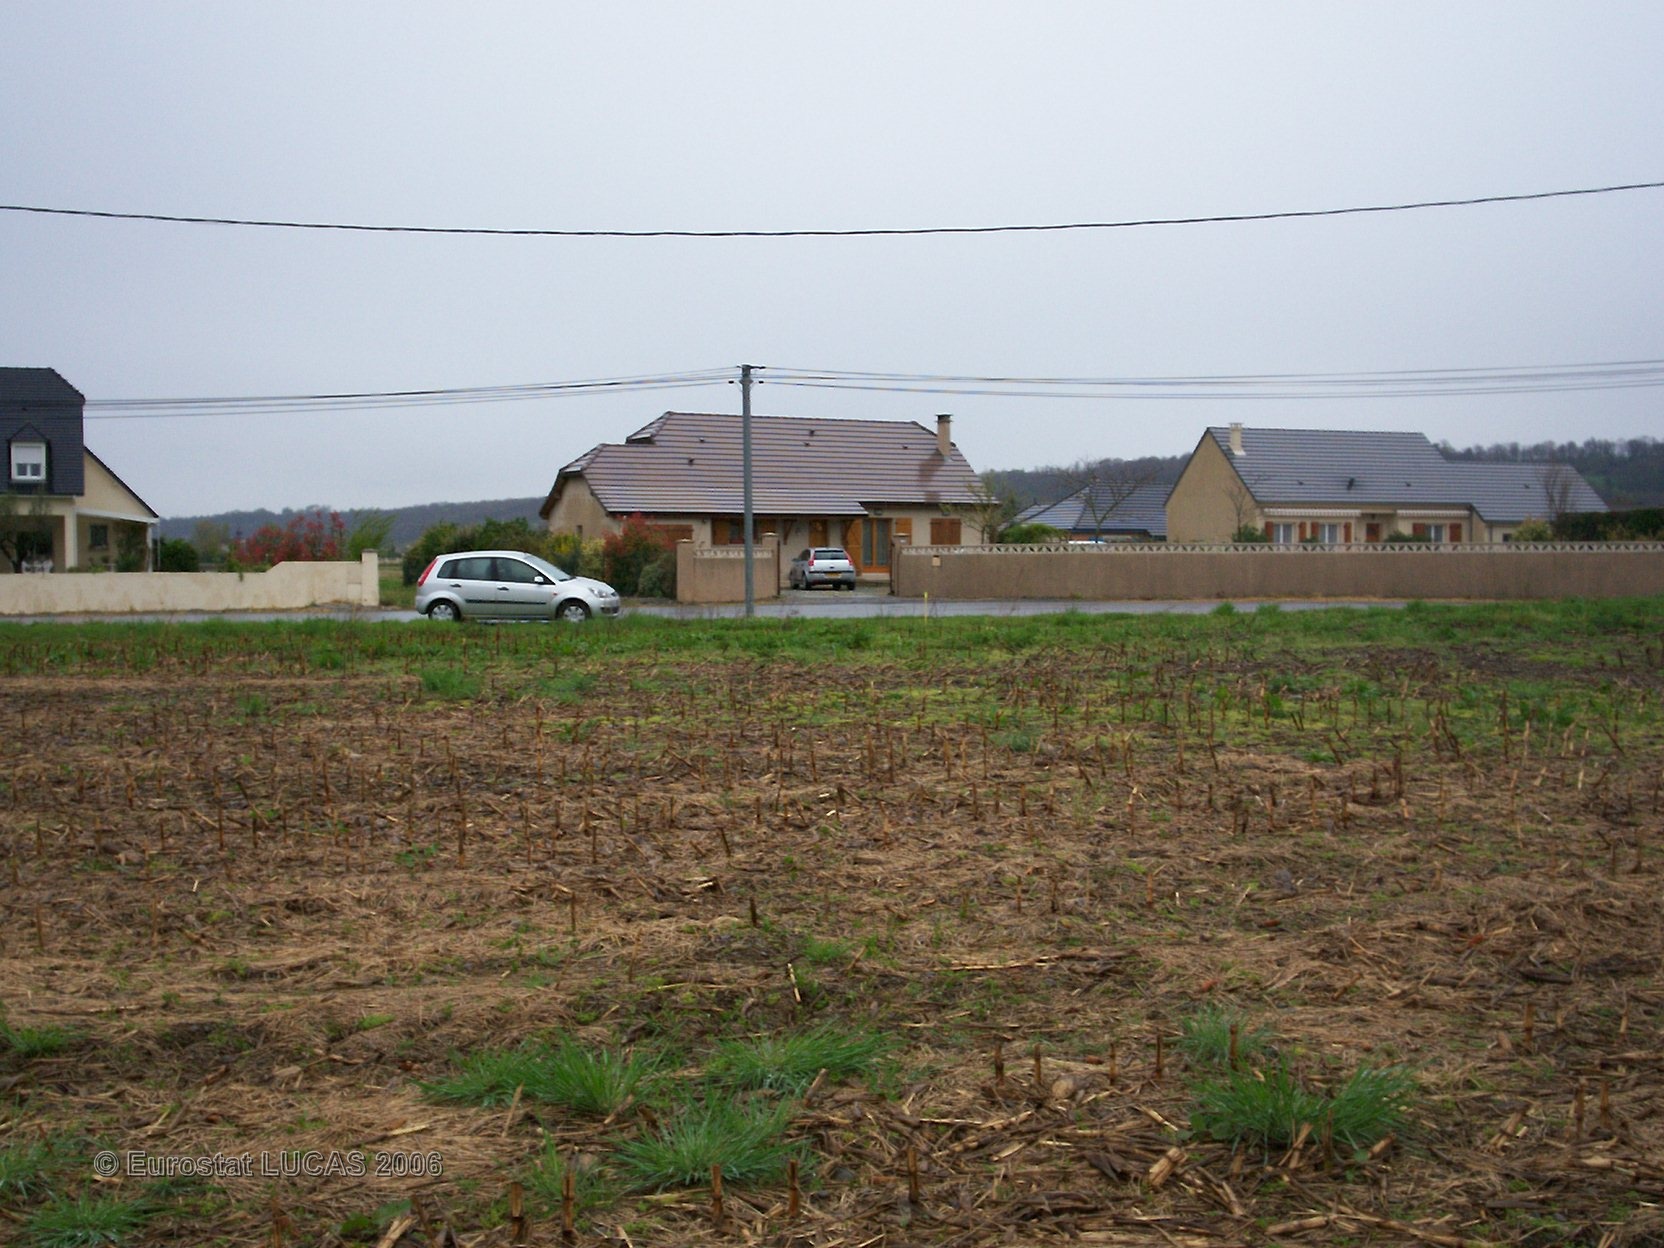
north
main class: Grassland
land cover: Grassland without tree/shrub cover
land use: Fallow land
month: June
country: FR
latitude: 43.2171
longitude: -0.1357
